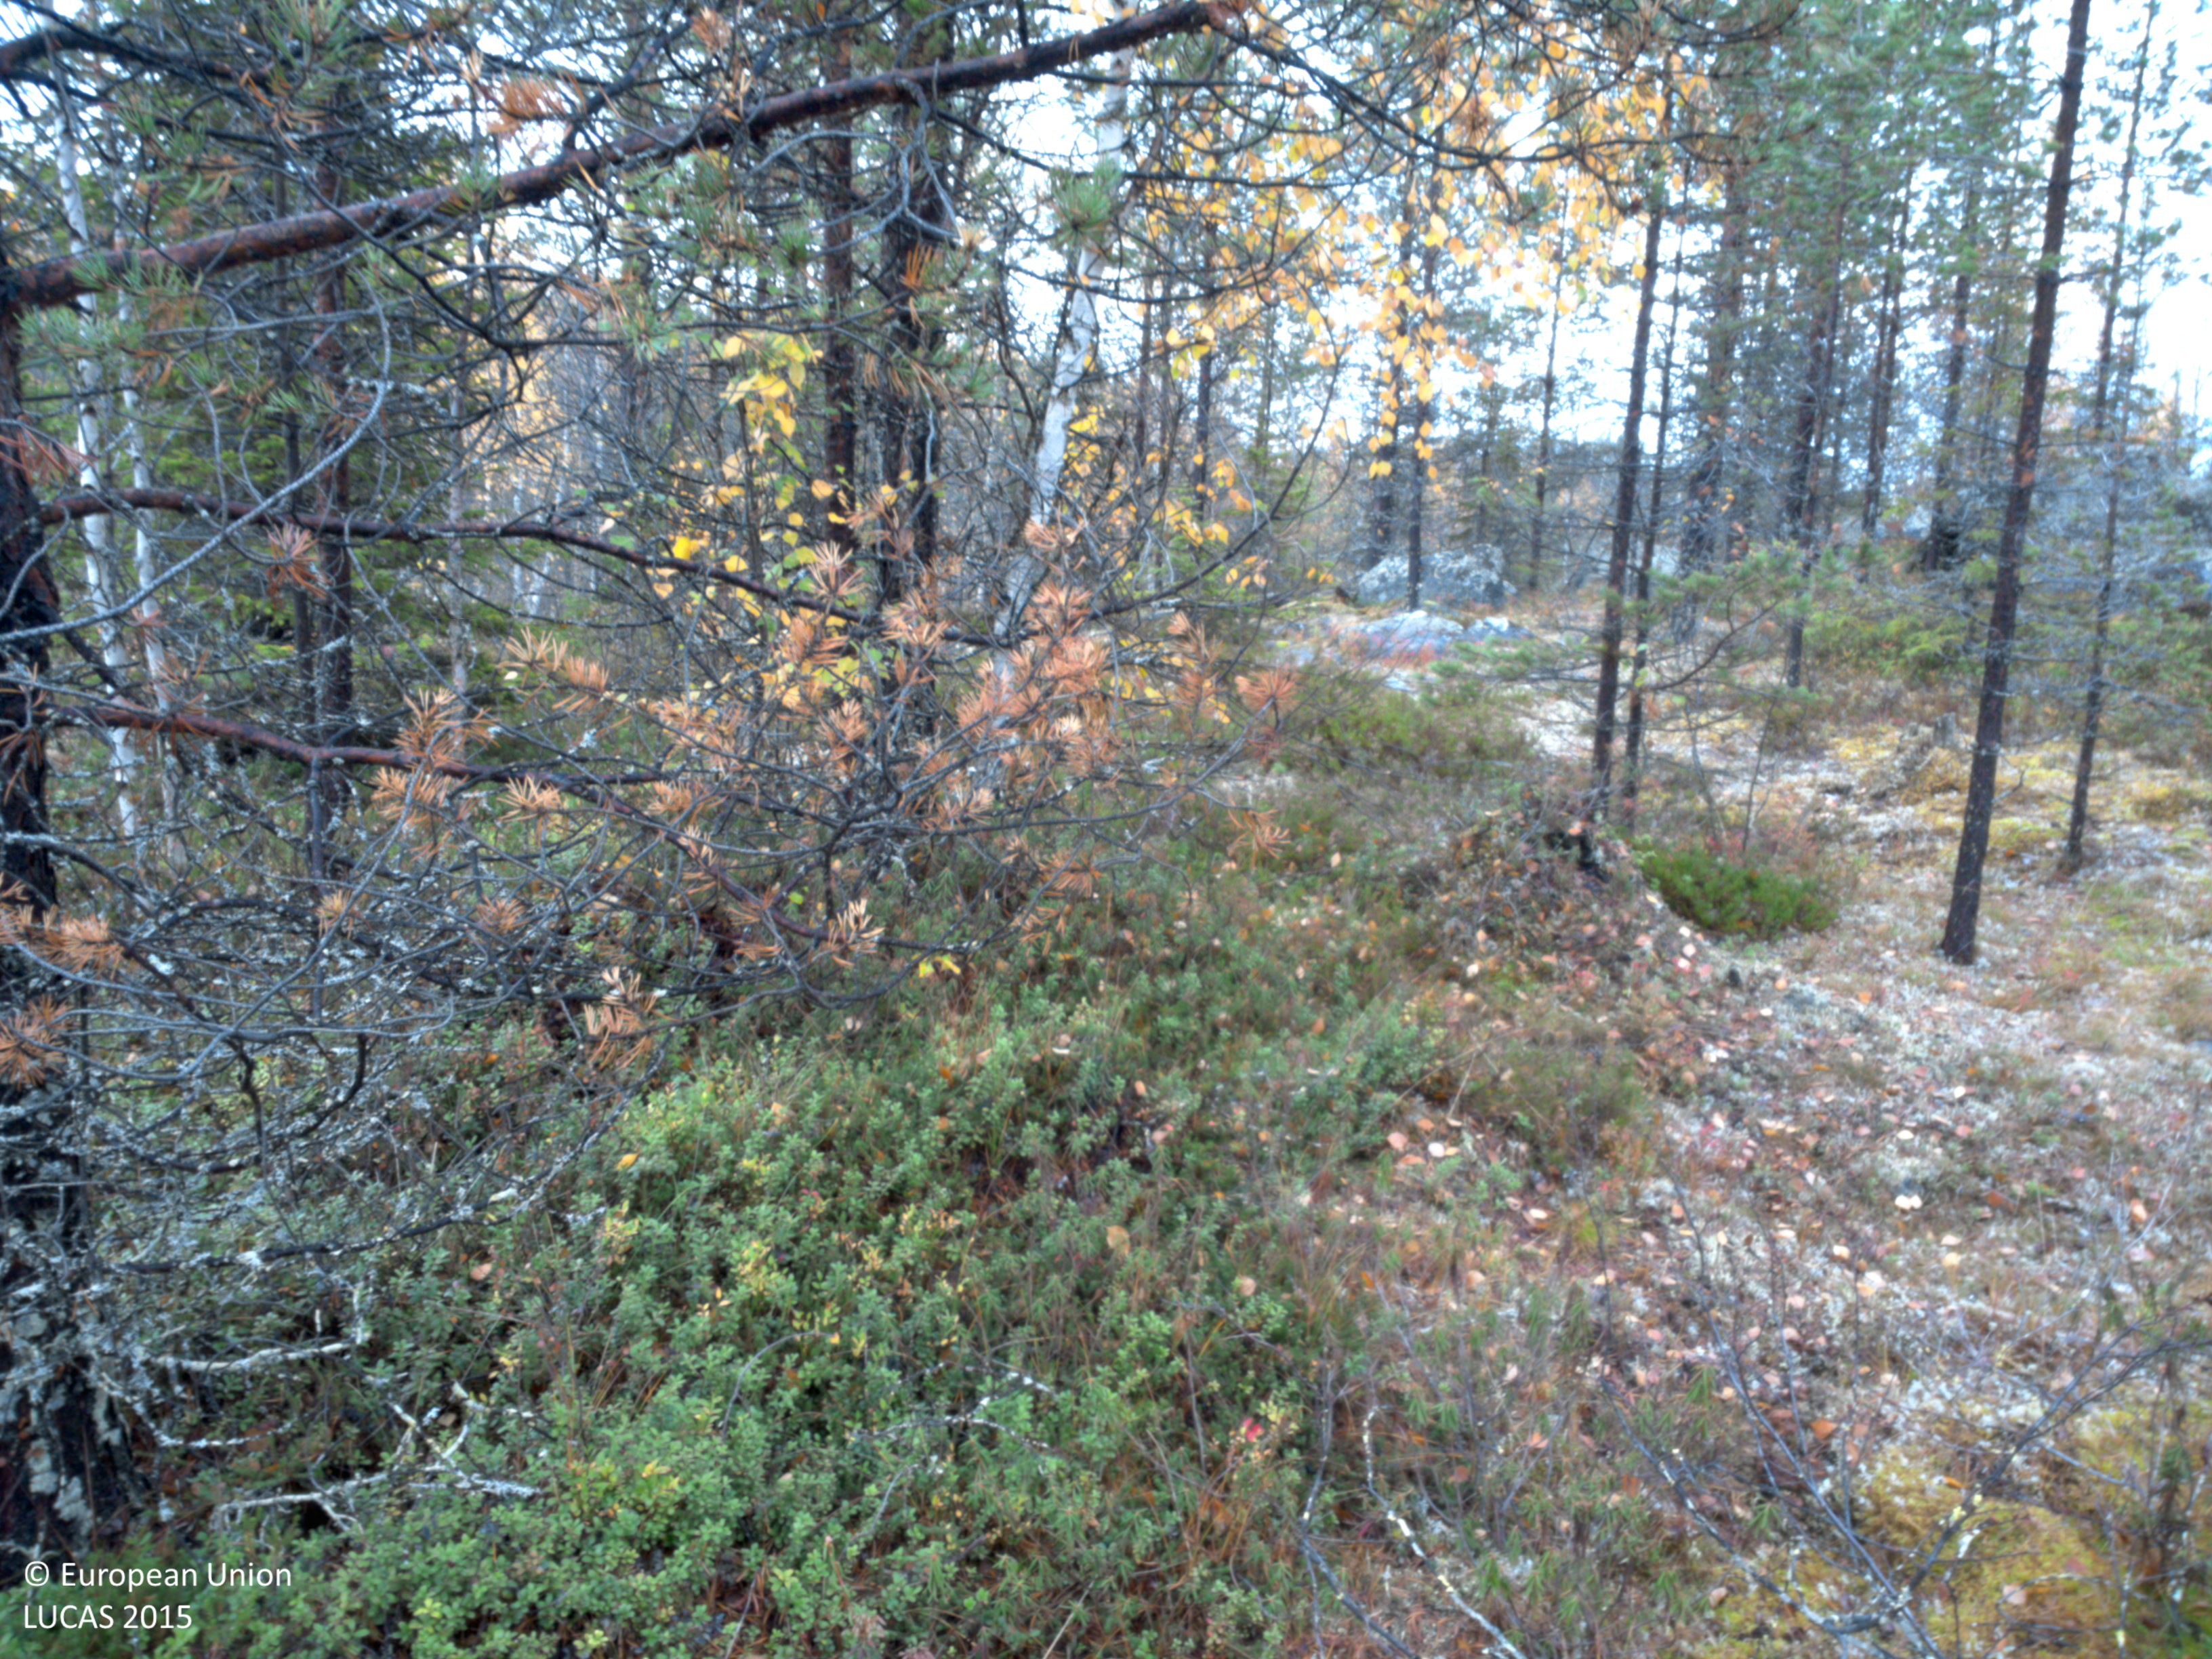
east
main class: Woodland
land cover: Pine dominated coniferous woodland
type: boreal forest
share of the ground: 50 - 75 %
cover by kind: coniferous forest trees 65 %, shrubs 20 %, broadleaved forest trees 5 %, herbaceous plants 5 %, lichens and mosses 5 %
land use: Forestry
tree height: > 5 m
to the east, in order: Pine dominated coniferous woodland; Pine dominated mixed woodland; Peatbogs; Pine dominated coniferous woodland; Ditches and canals; Pine dominated coniferous woodland; Pine dominated mixed woodland; Ditches and canals; Pine dominated mixed woodland; Other mixed woodland; Pine dominated mixed woodland
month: September
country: SE
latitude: 64.8871
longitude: 19.0259
